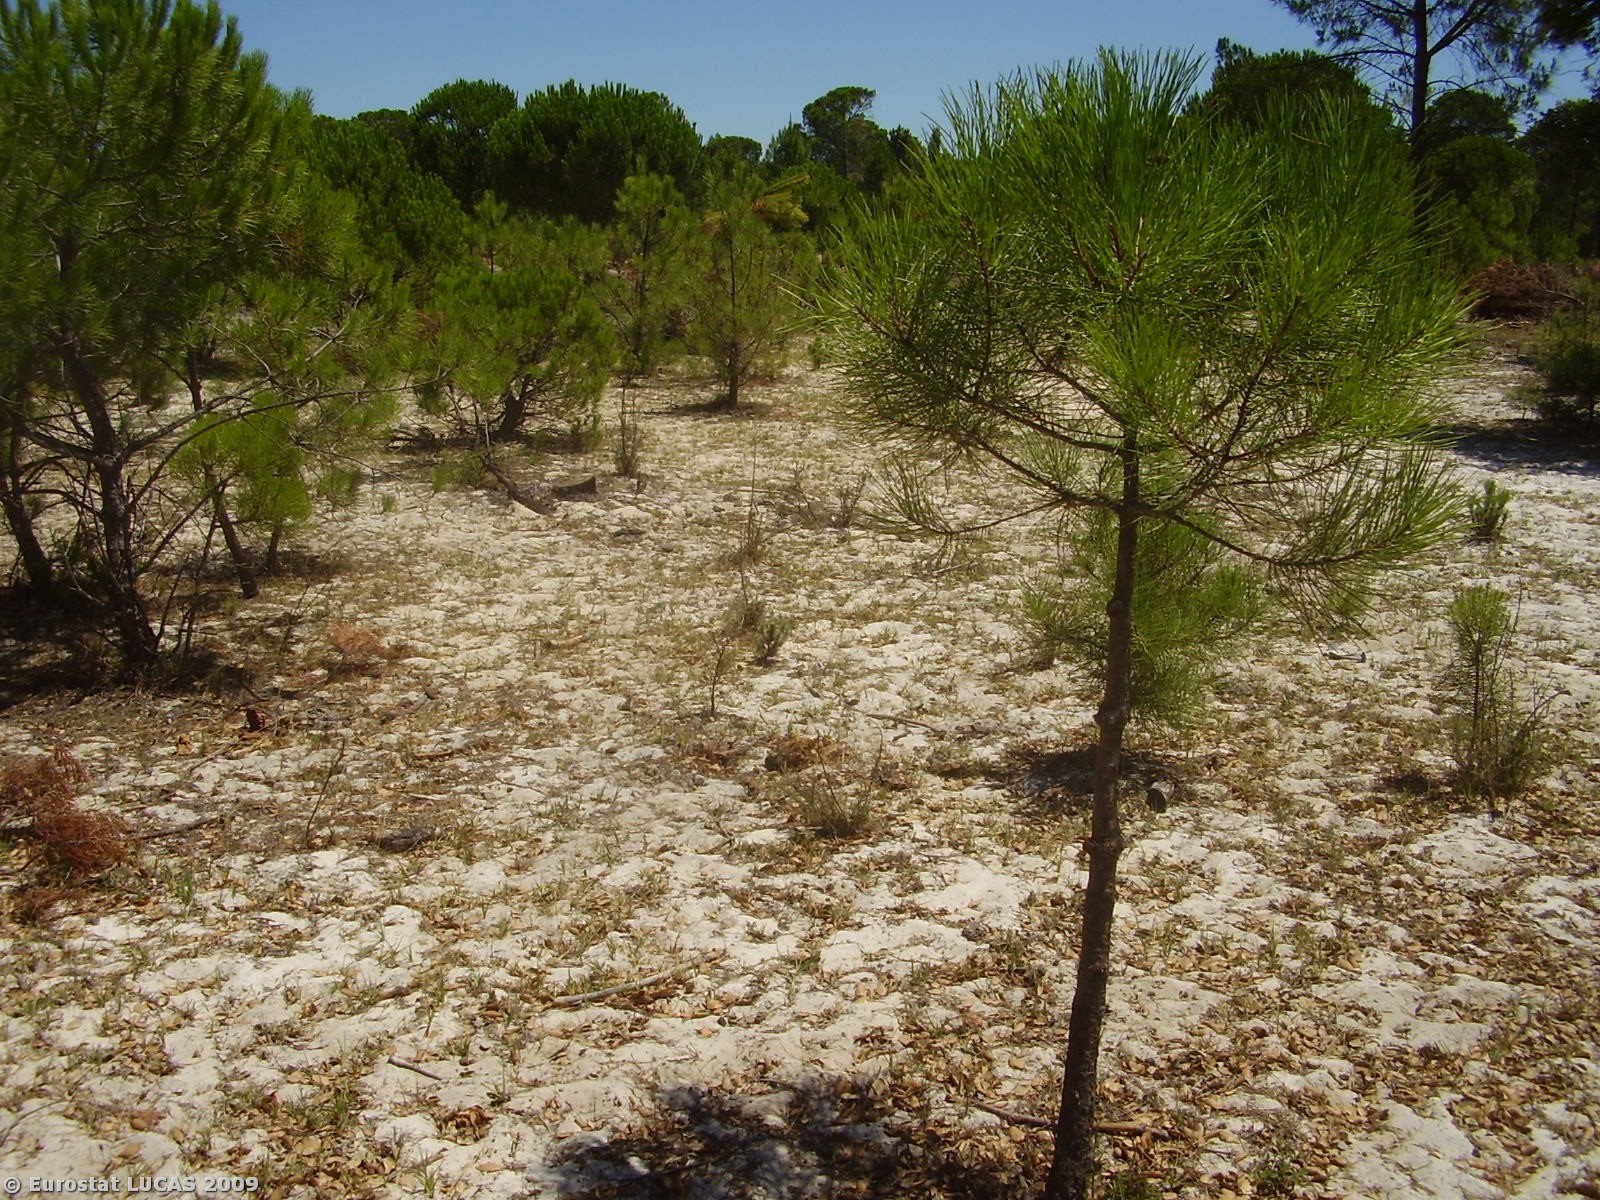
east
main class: Woodland
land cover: Coniferous woodland
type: coniferous forest of the mediterranean region
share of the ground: 10 - 25 %
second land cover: Grassland with sparse tree/shrub cover
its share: 10 - 25 %
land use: Forestry
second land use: Fallow land
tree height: > 5 m
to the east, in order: Coniferous woodland; Grassland with sparse tree/shrub cover; Coniferous woodland; Fences; Tracks; Coniferous woodland
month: July
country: PT
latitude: 38.1922
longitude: -8.4161
